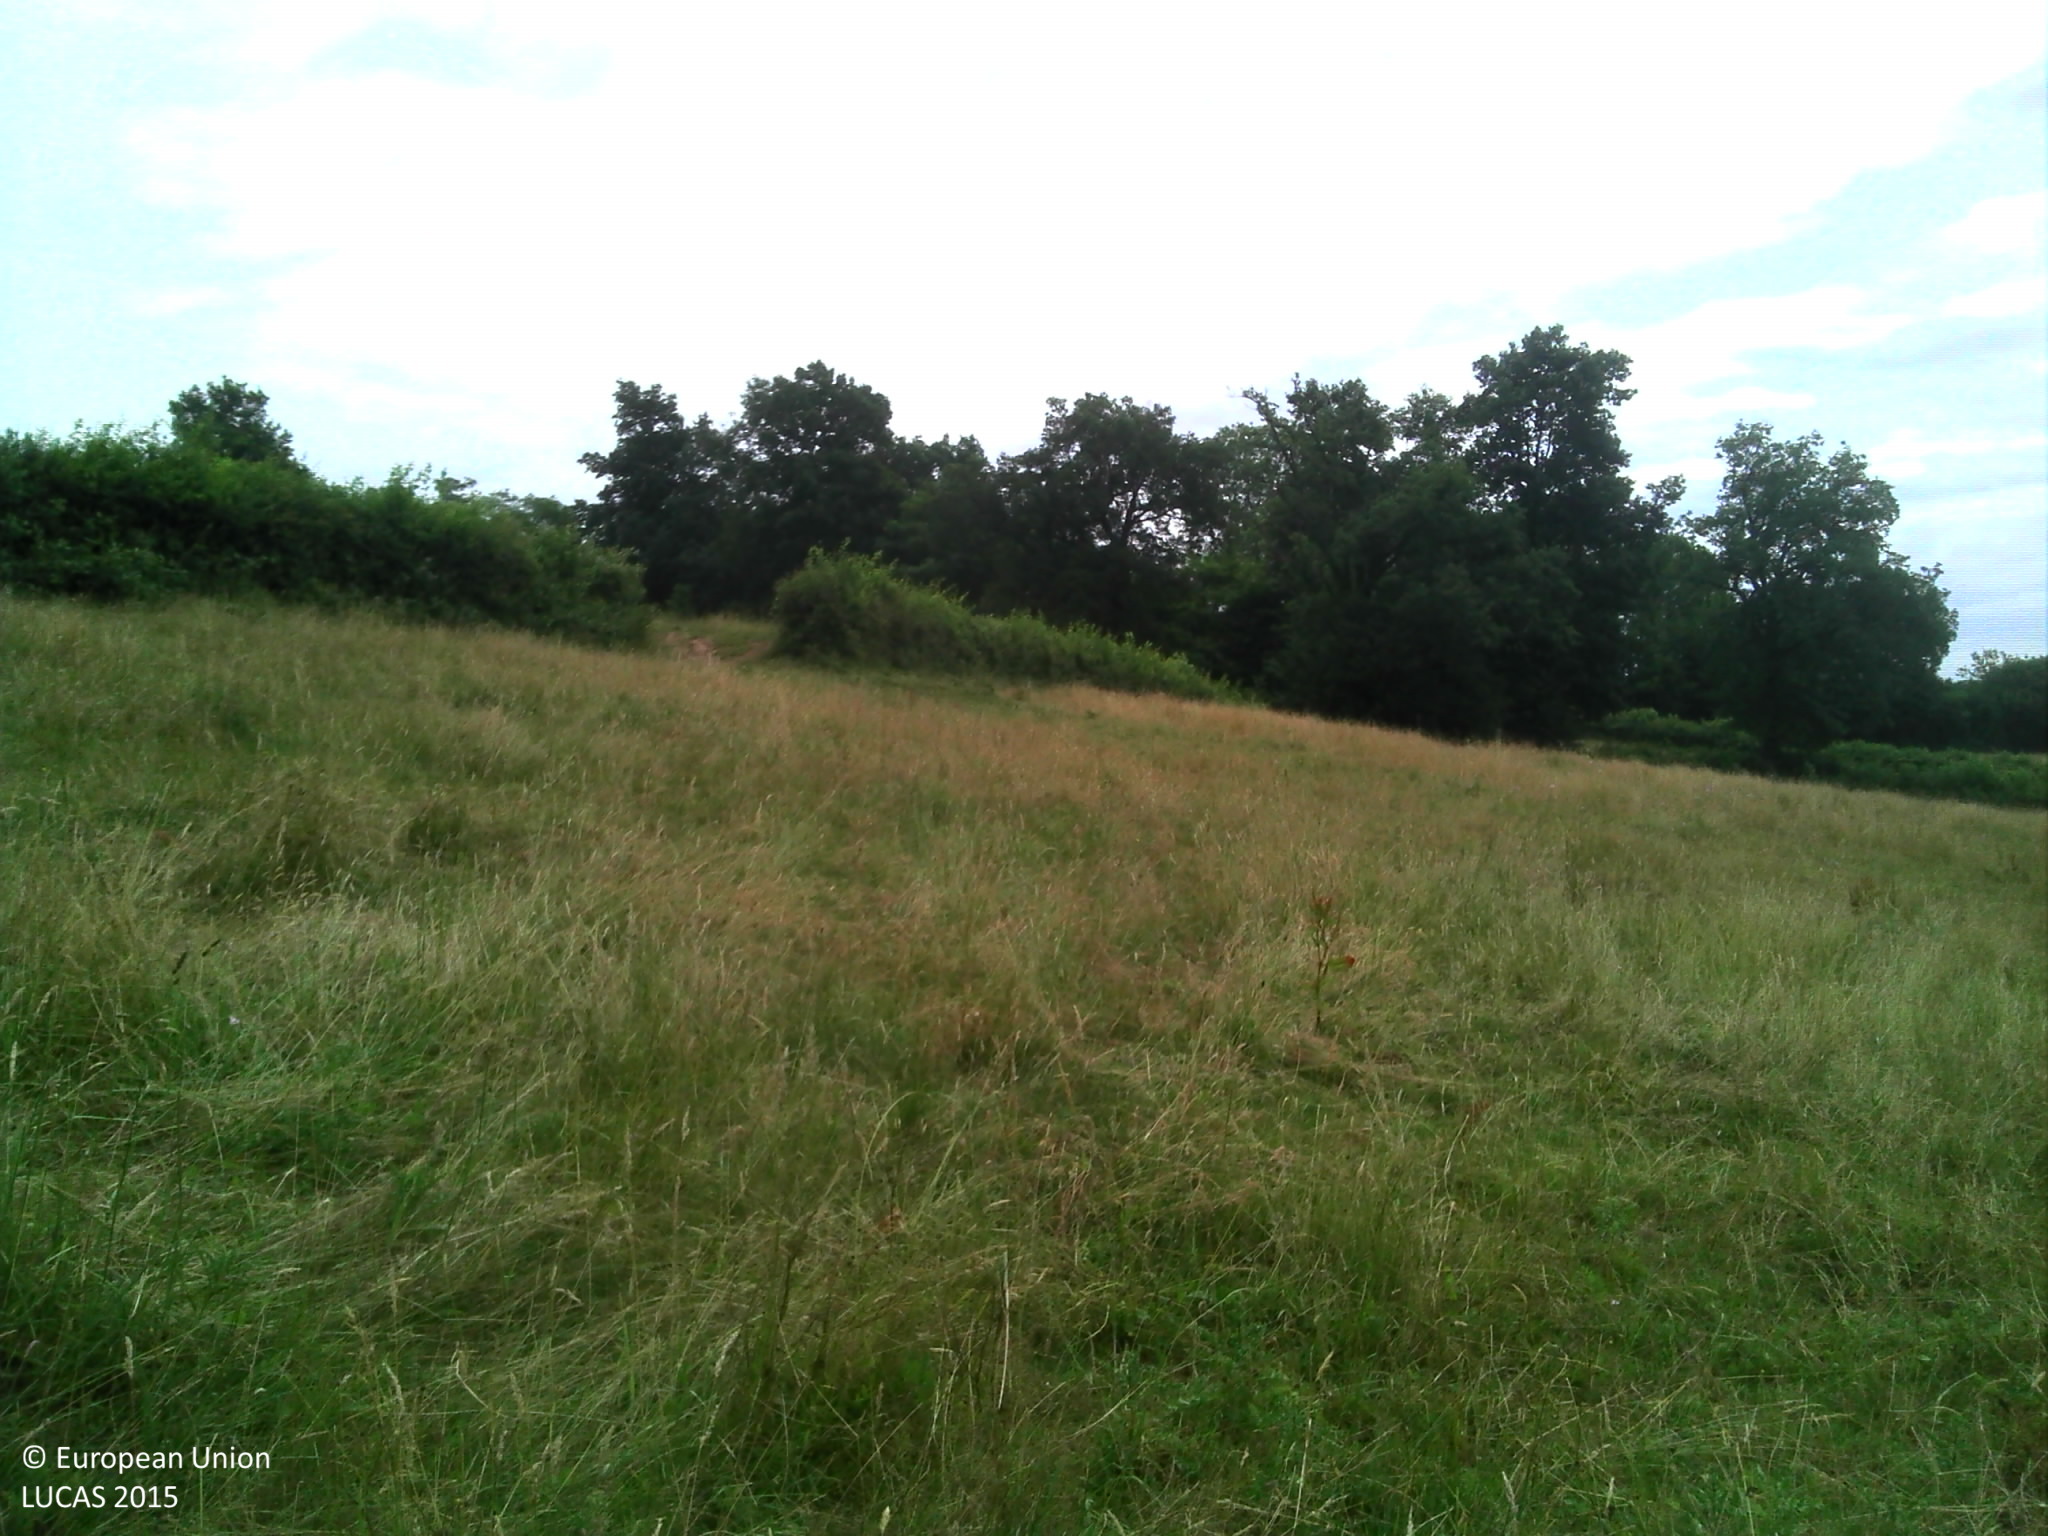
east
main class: Grassland
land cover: Grassland without tree/shrub cover
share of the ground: > 75 %
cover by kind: herbaceous plants 100 %
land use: Agriculture (excluding fallow land and kitchen gardens)
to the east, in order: Grassland without tree/shrub cover; Abandoned hedges; Grassland without tree/shrub cover; Broadleaved woodland; Tracks; Broadleaved woodland; Fences; Grassland without tree/shrub cover; Single bushes/trees; Grassland without tree/shrub cover; Ditches and canals; Grassland without tree/shrub cover; Abandoned hedges; Grassland without tree/shrub cover; Abandoned hedges; Grassland without tree/shrub cover
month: June
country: FR
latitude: 46.5878
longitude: 4.4804
